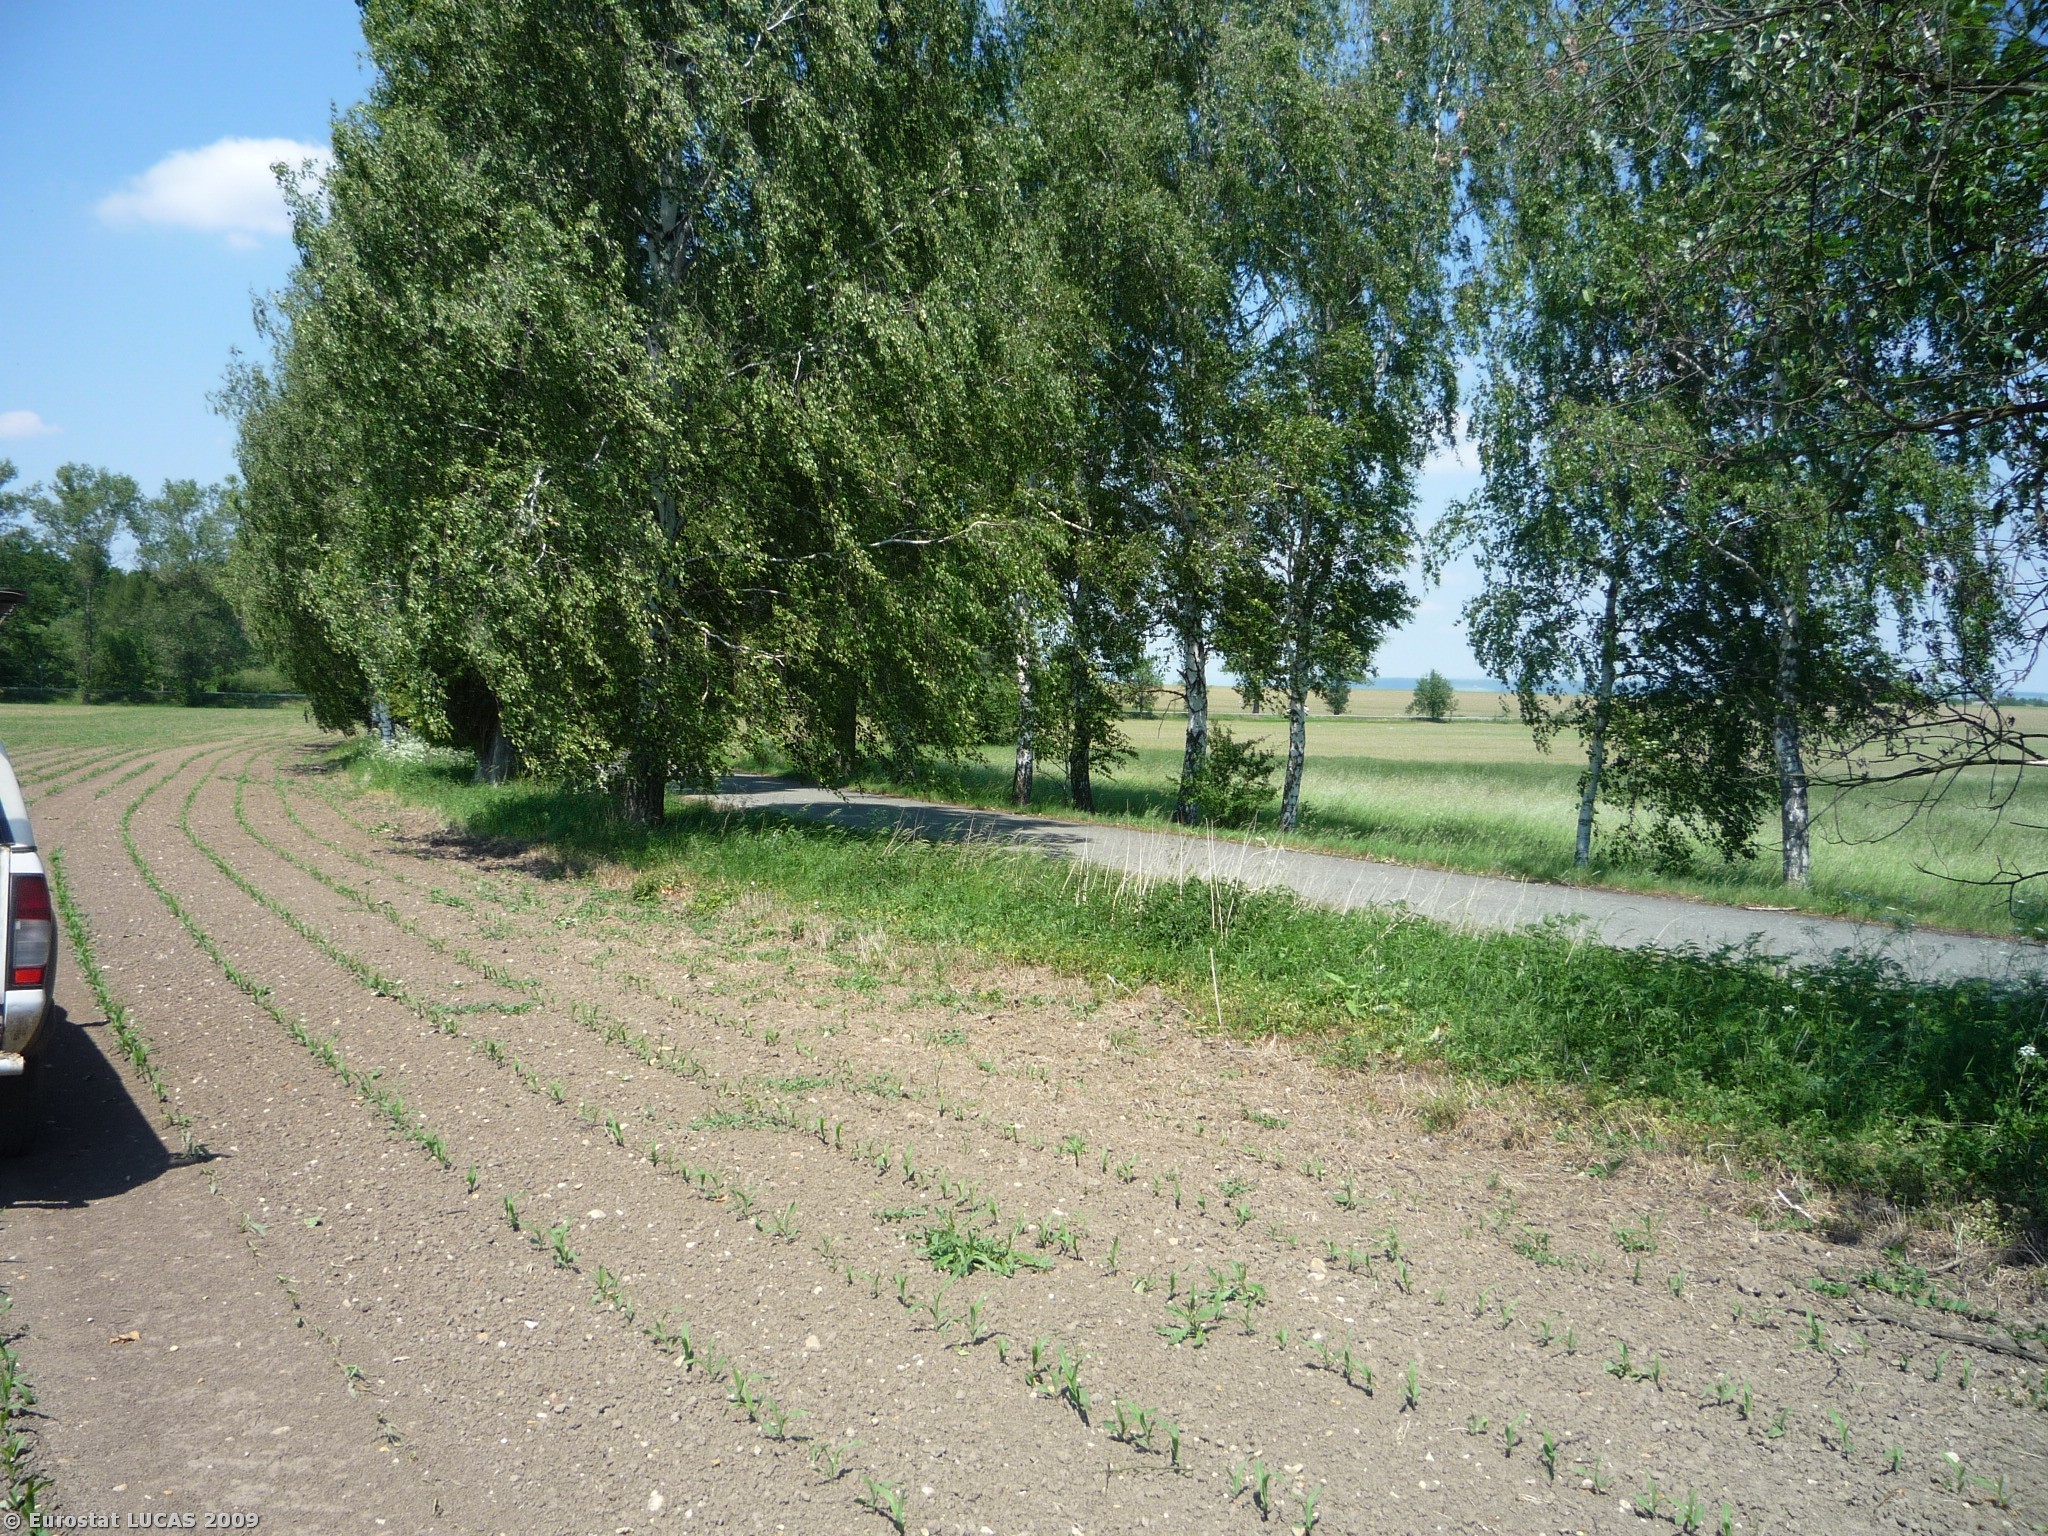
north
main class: Cropland
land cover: Maize
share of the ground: 10 - 25 %
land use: Agriculture (excluding fallow land and kitchen gardens)
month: May
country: CZ
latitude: 50.2835
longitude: 15.5477
